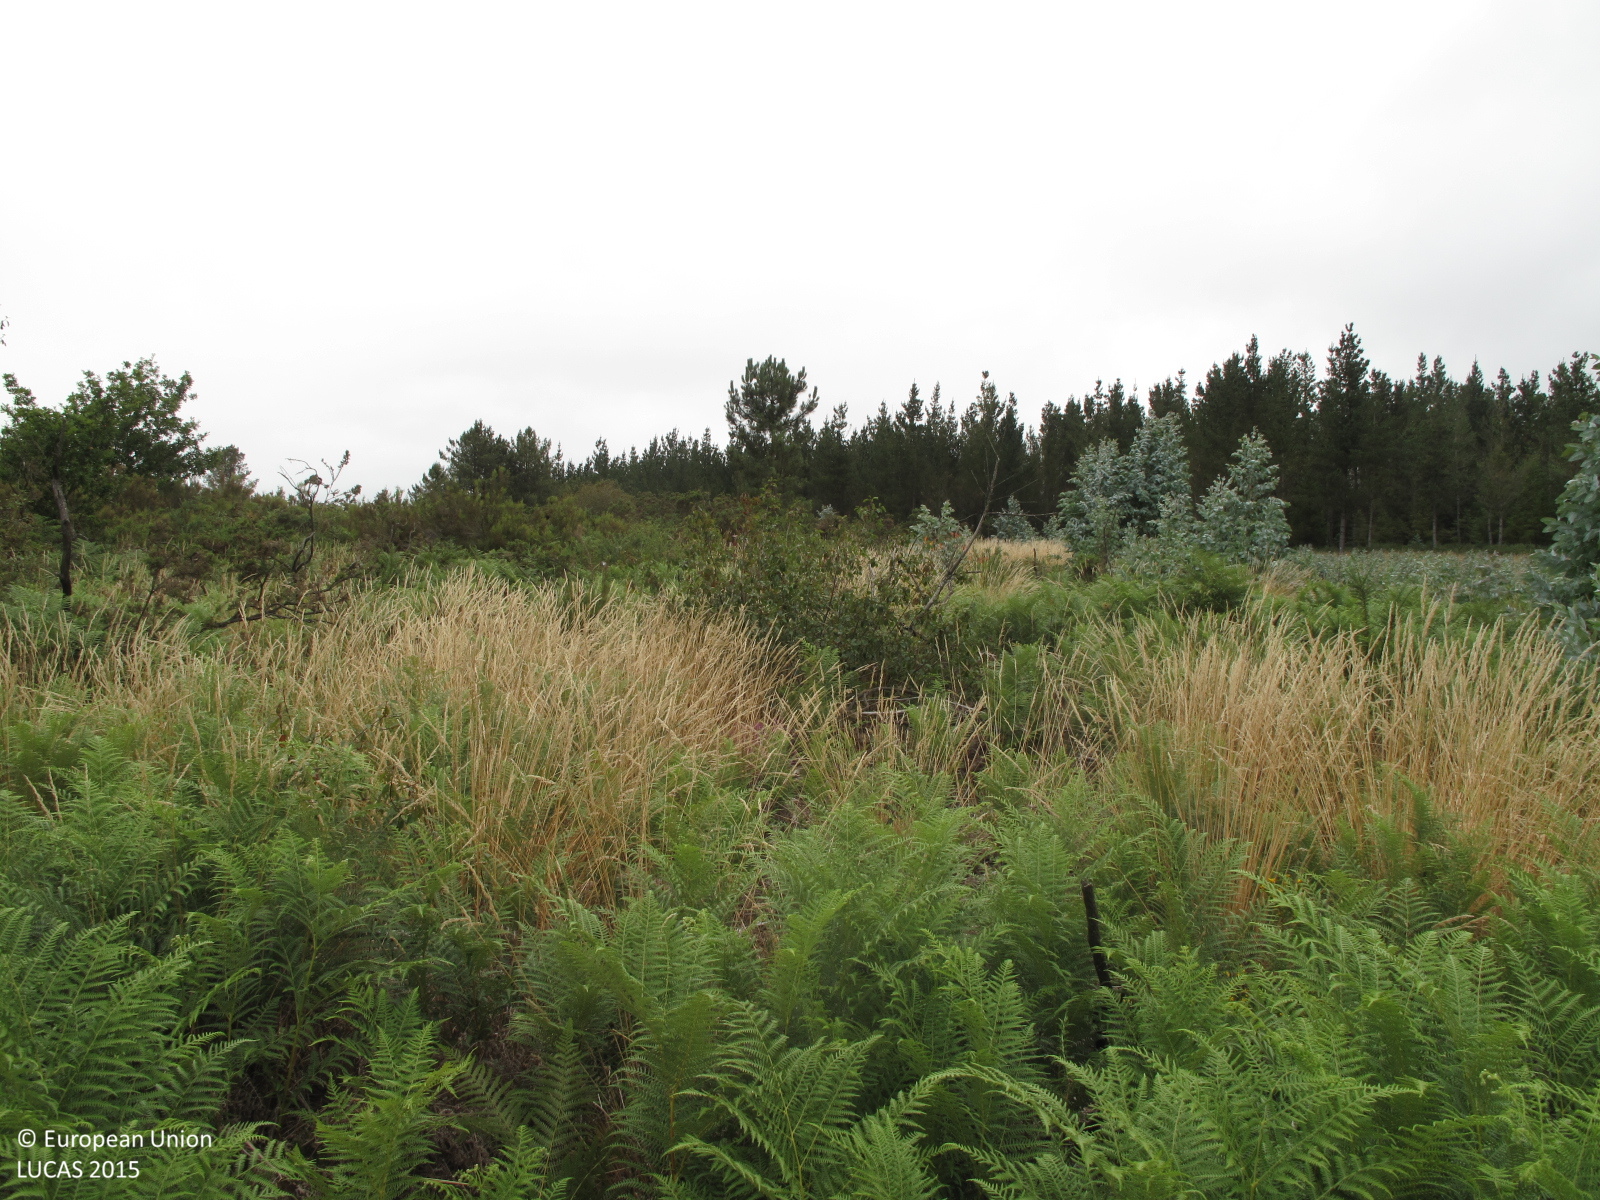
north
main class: Shrubland
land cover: Shrubland with sparse tree cover
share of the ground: 10 - 25 %
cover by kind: herbaceous plants 70 %, shrubs 15 %, lichens and mosses 10 %, broadleaved forest trees 5 %
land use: Abandoned areas
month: July
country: ES
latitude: 43.1683
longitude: -7.9887
